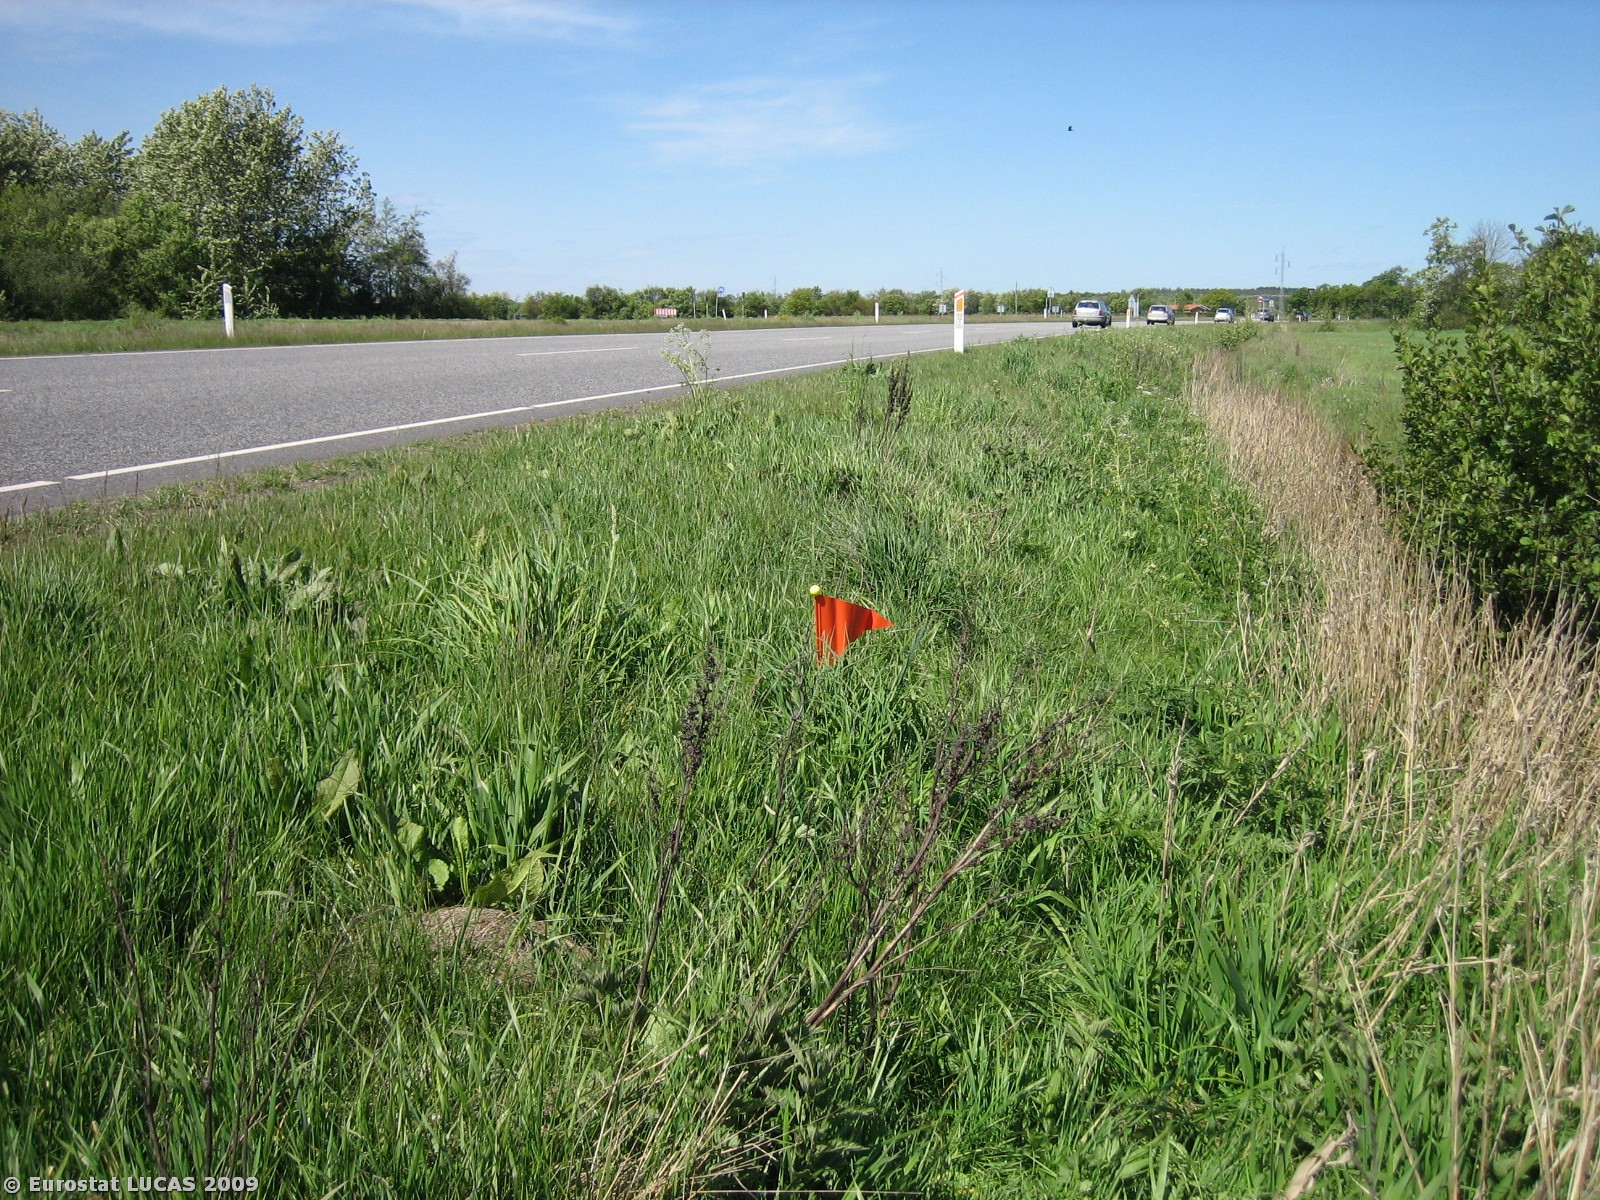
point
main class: Grassland
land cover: Grassland without tree/shrub cover
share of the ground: > 75 %
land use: Unused
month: May
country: DK
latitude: 55.9630
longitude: 8.4797
